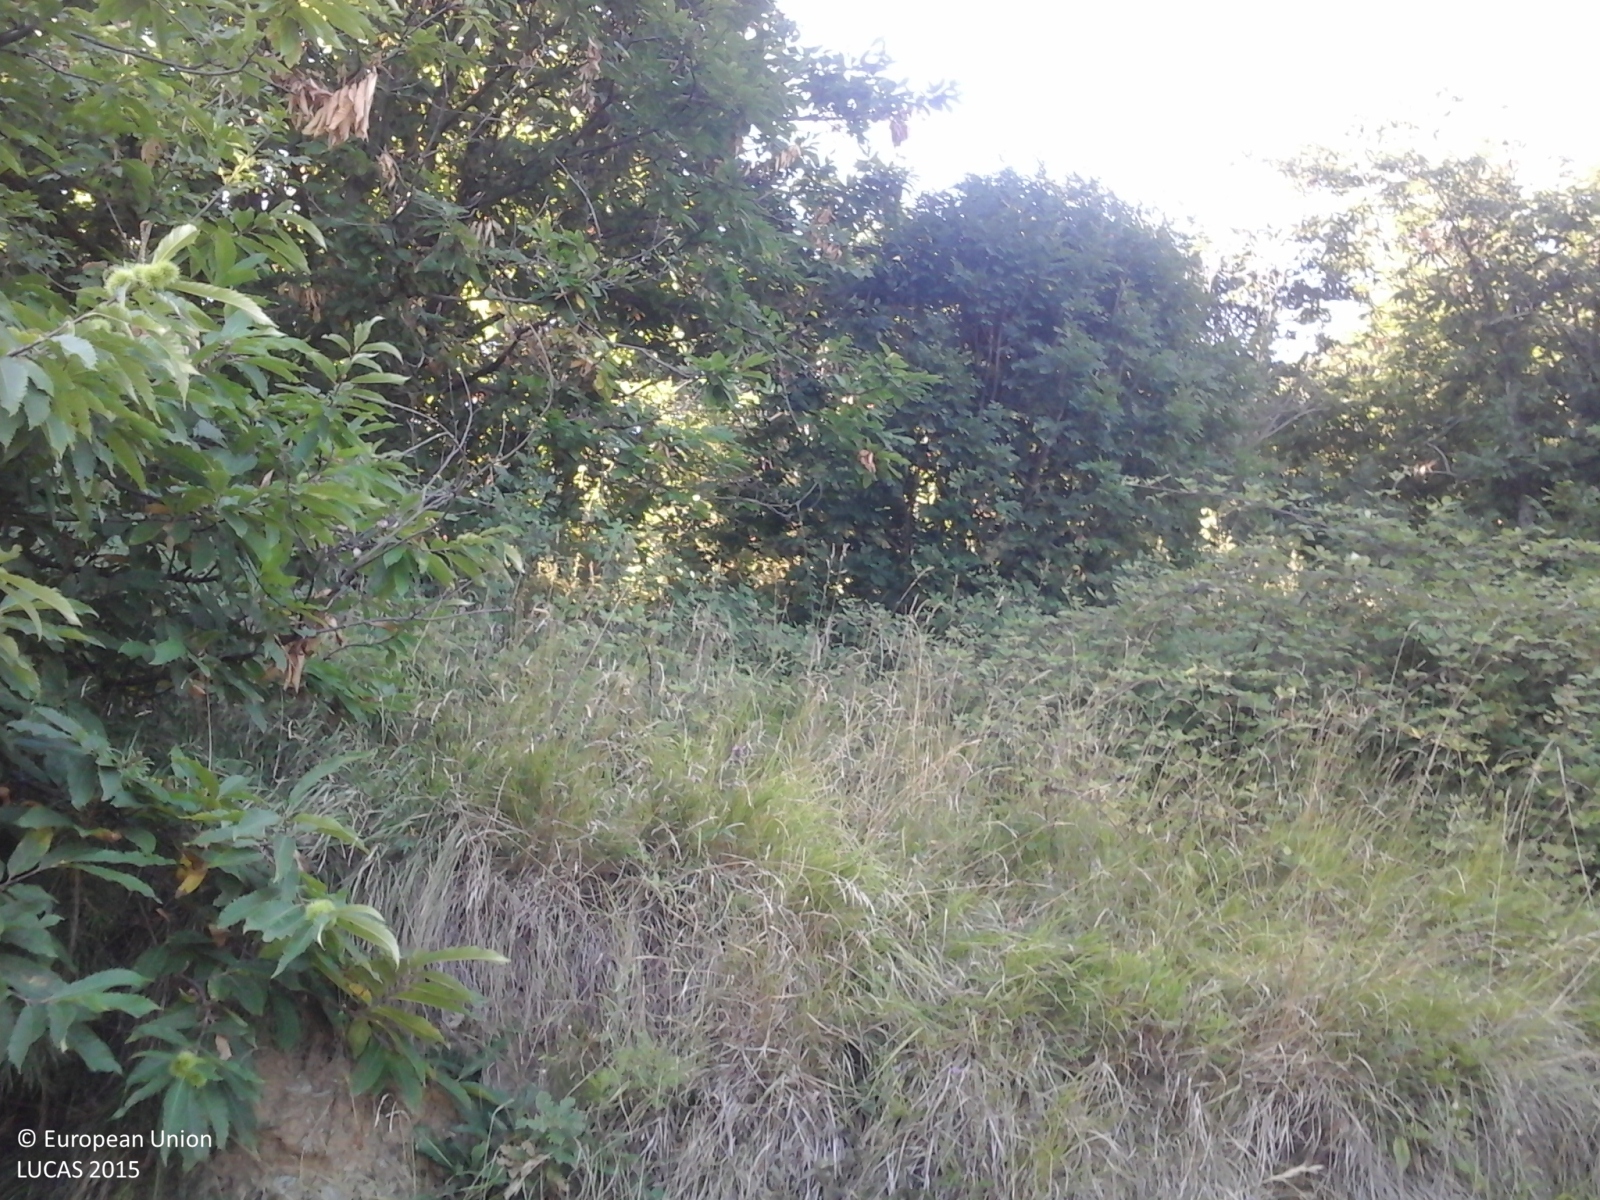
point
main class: Woodland
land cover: Broadleaved woodland
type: thermophilous deciduous forest
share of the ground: > 75 %
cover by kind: broadleaved forest trees 80 %, shrubs 10 %, coniferous forest trees 5 %, herbaceous plants 5 %
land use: Semi-natural and natural areas not in use
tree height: > 5 m
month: August
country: IT
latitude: 44.4688
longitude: 8.7081
